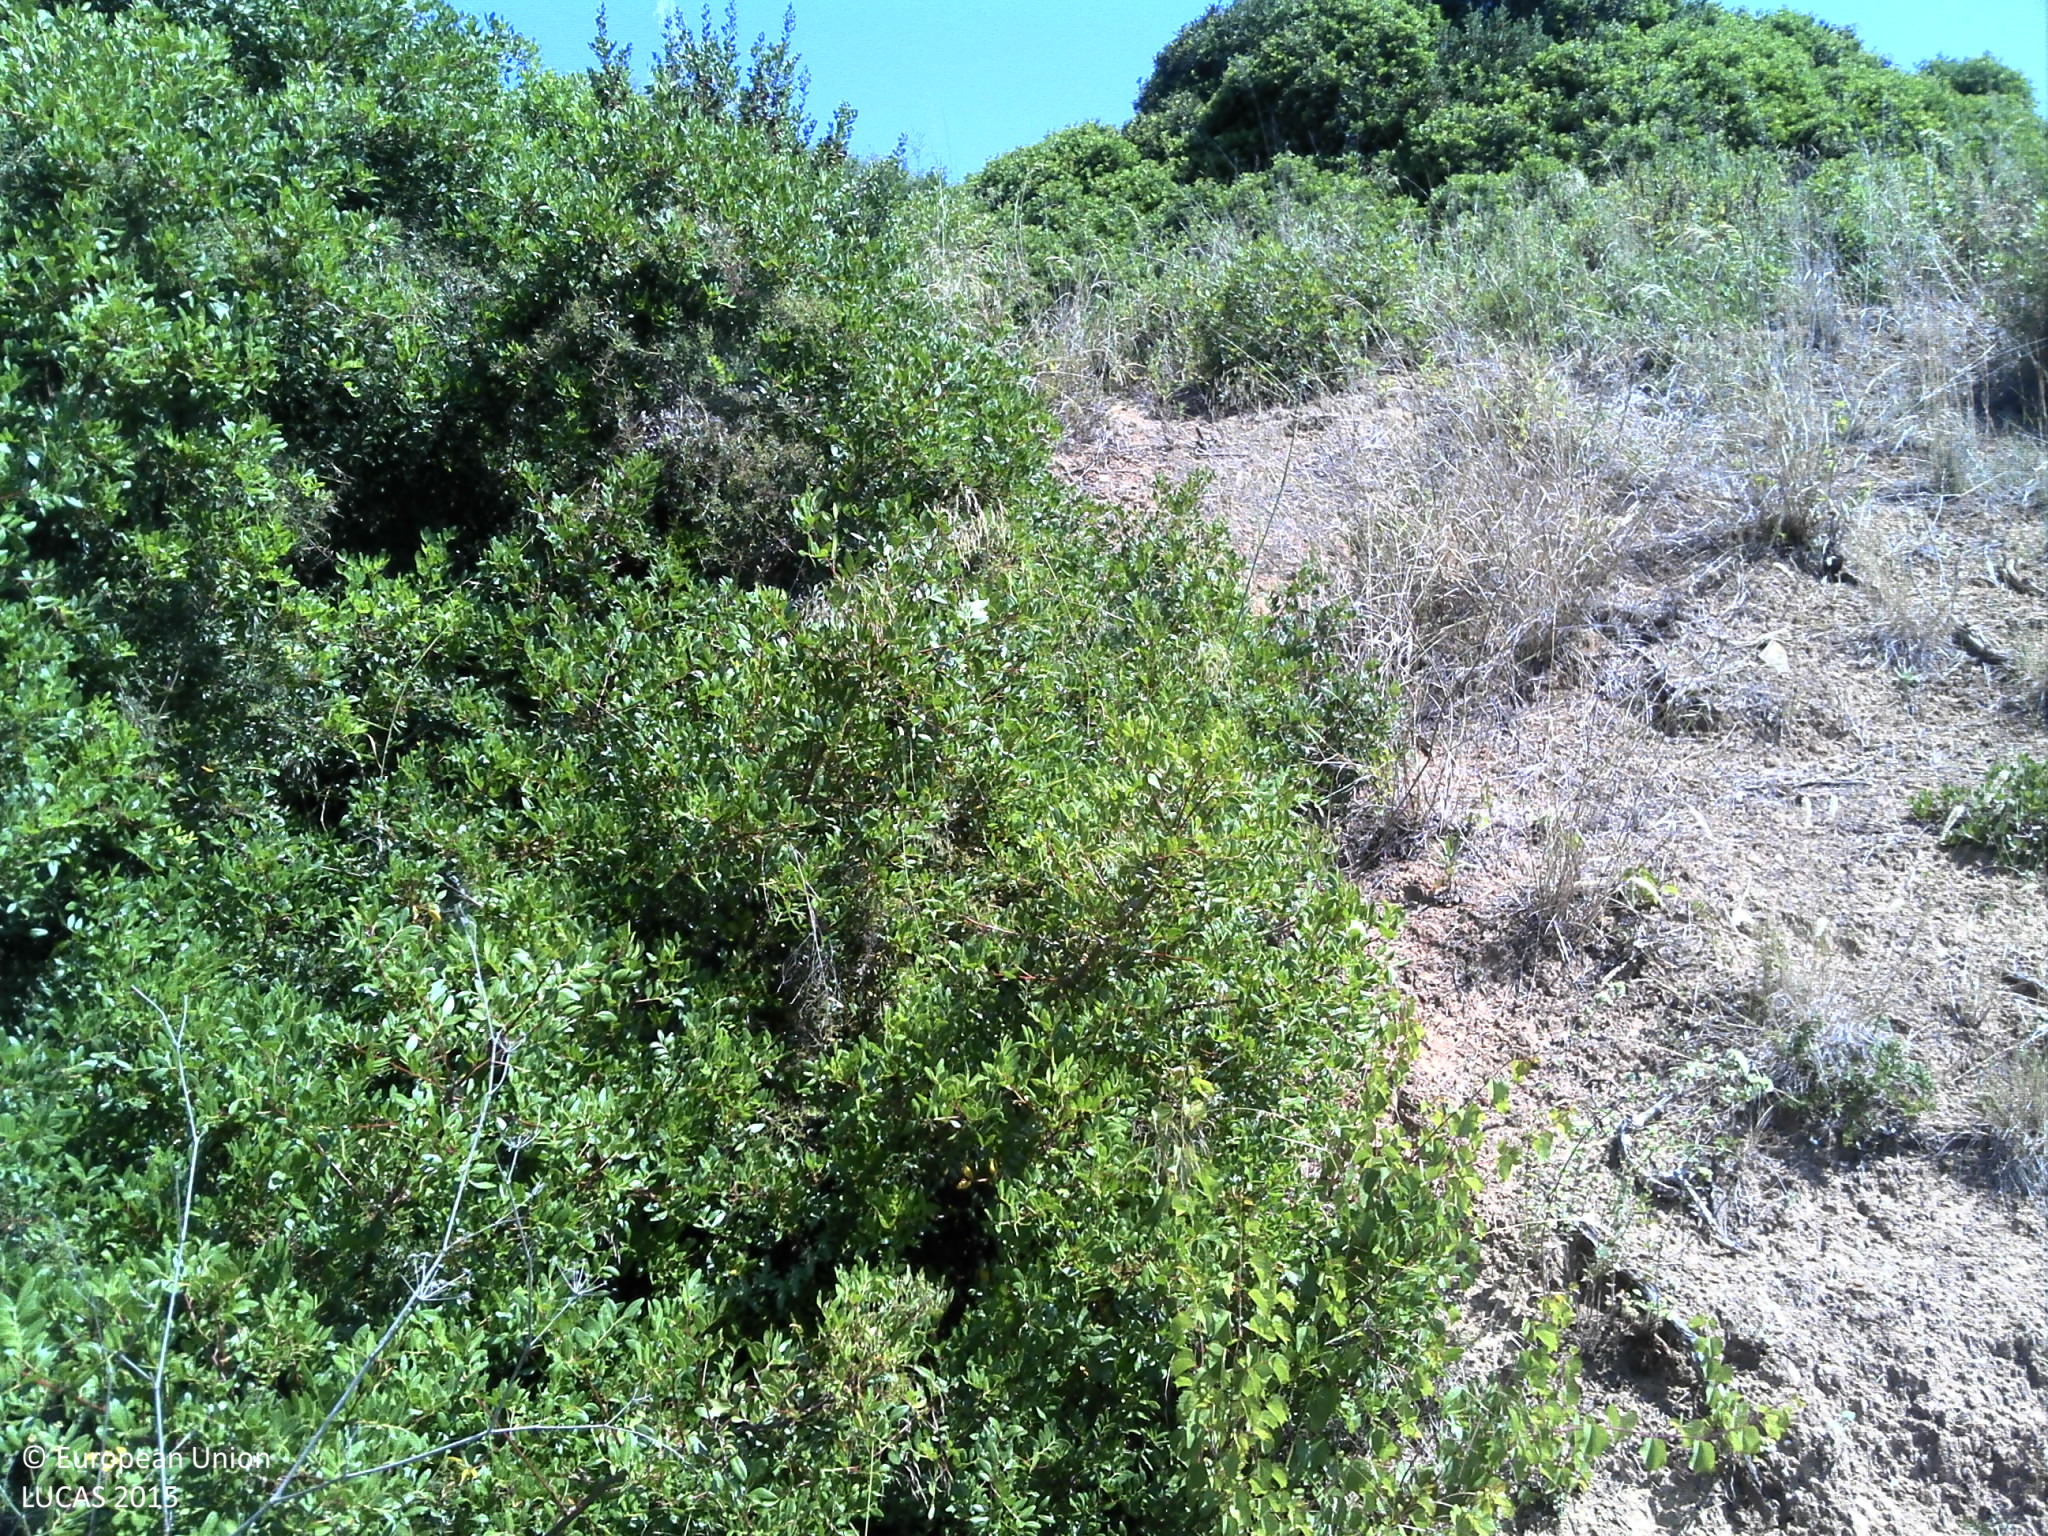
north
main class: Shrubland
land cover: Shrubland with sparse tree cover
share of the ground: 50 - 75 %
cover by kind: shrubs 70 %, unconsolidated bare surface 15 %, herbaceous plants 10 %, broadleaved forest trees 5 %
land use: Abandoned areas
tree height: > 5 m
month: June
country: PT
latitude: 39.0968
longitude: -9.2688
